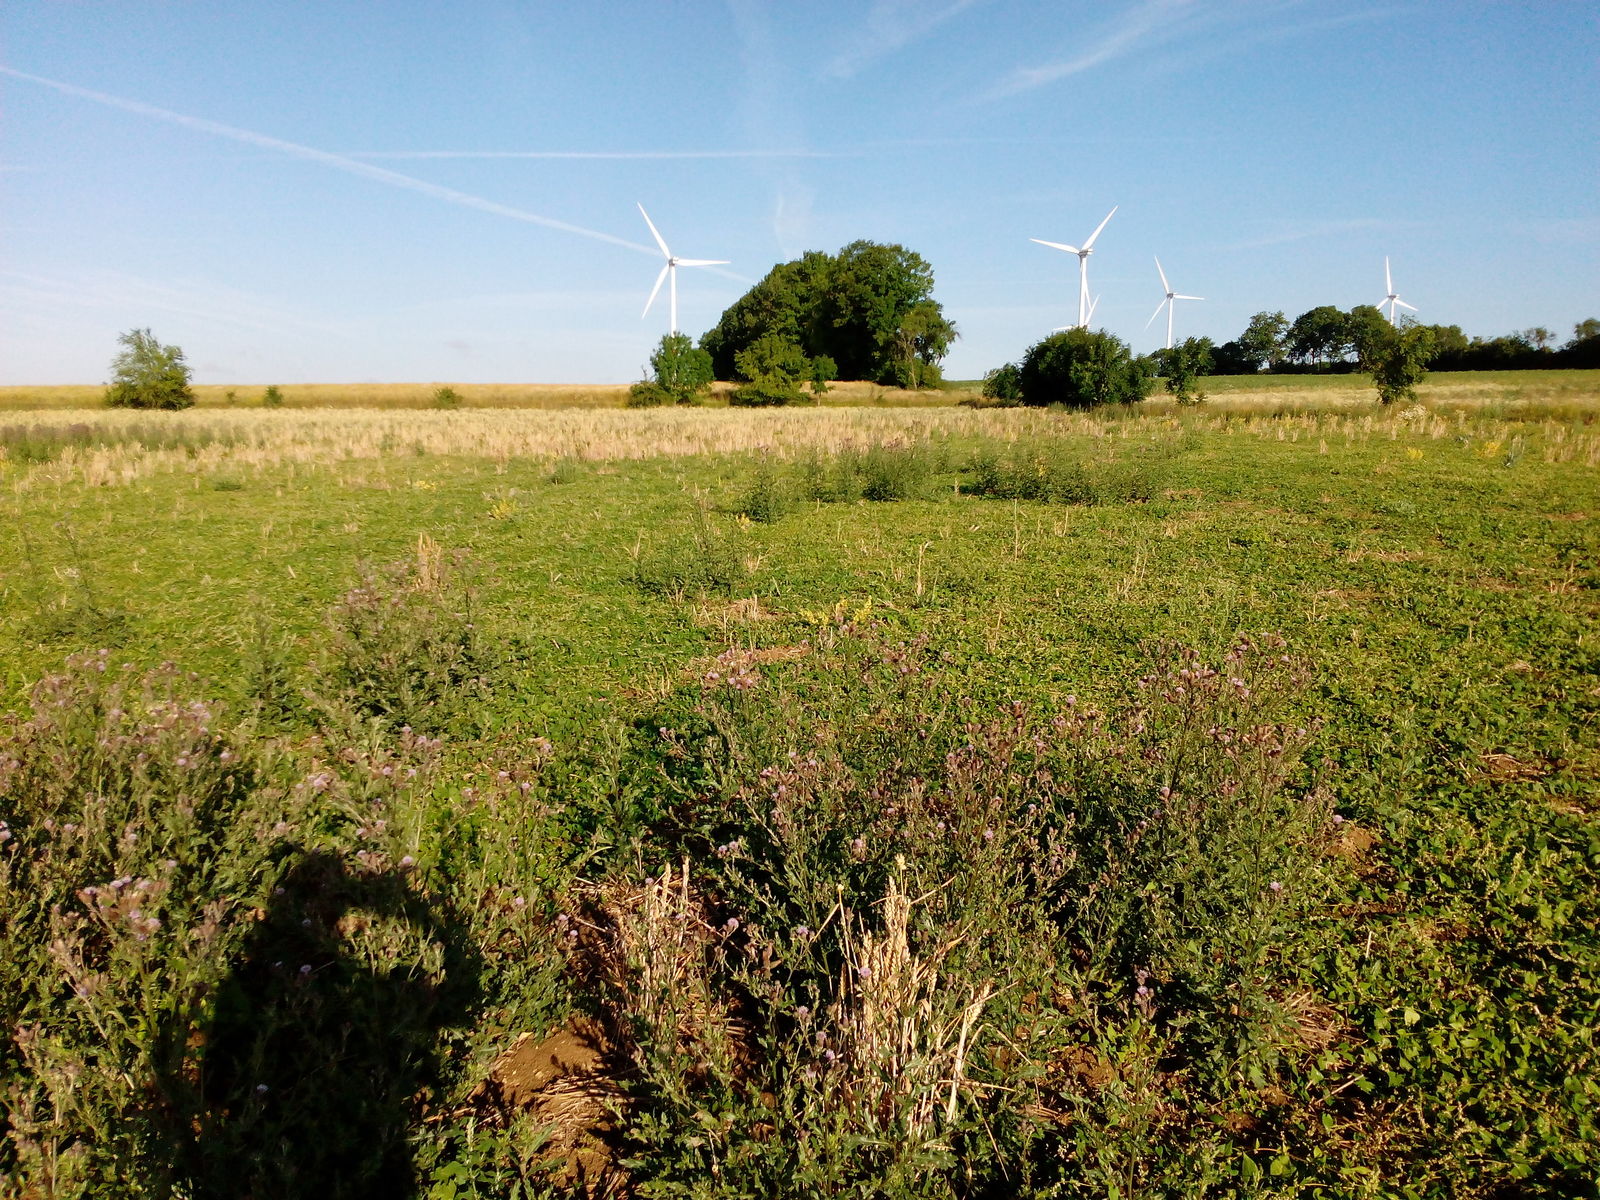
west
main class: Grassland
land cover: Spontaneously vegetated surfaces
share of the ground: > 75 %
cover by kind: herbaceous plants 100 %
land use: Fallow land
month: July
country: DE
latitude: 51.2952
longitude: 10.9319
